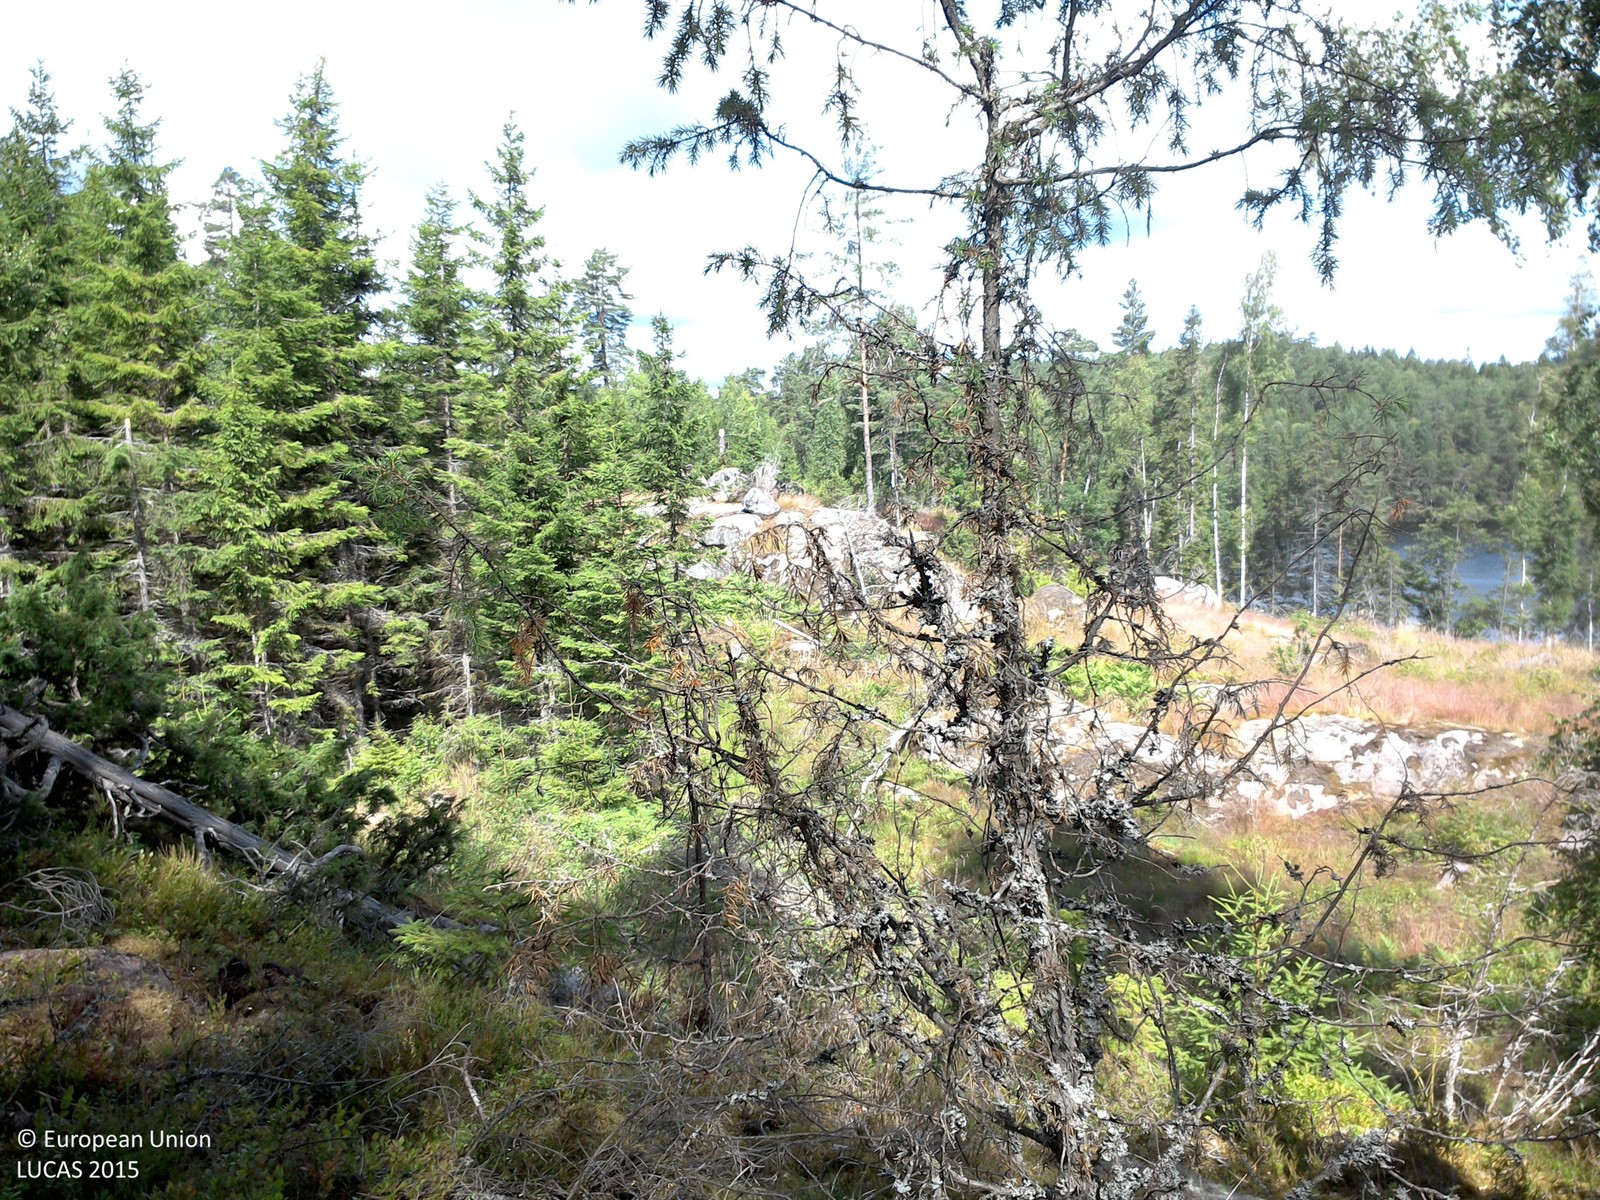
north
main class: Woodland
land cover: Pine dominated coniferous woodland
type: boreal forest
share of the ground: 50 - 75 %
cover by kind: coniferous forest trees 60 %, herbaceous plants 25 %, lichens and mosses 15 %
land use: Forestry
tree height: > 5 m
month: July
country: SE
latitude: 57.8311
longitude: 16.0426
